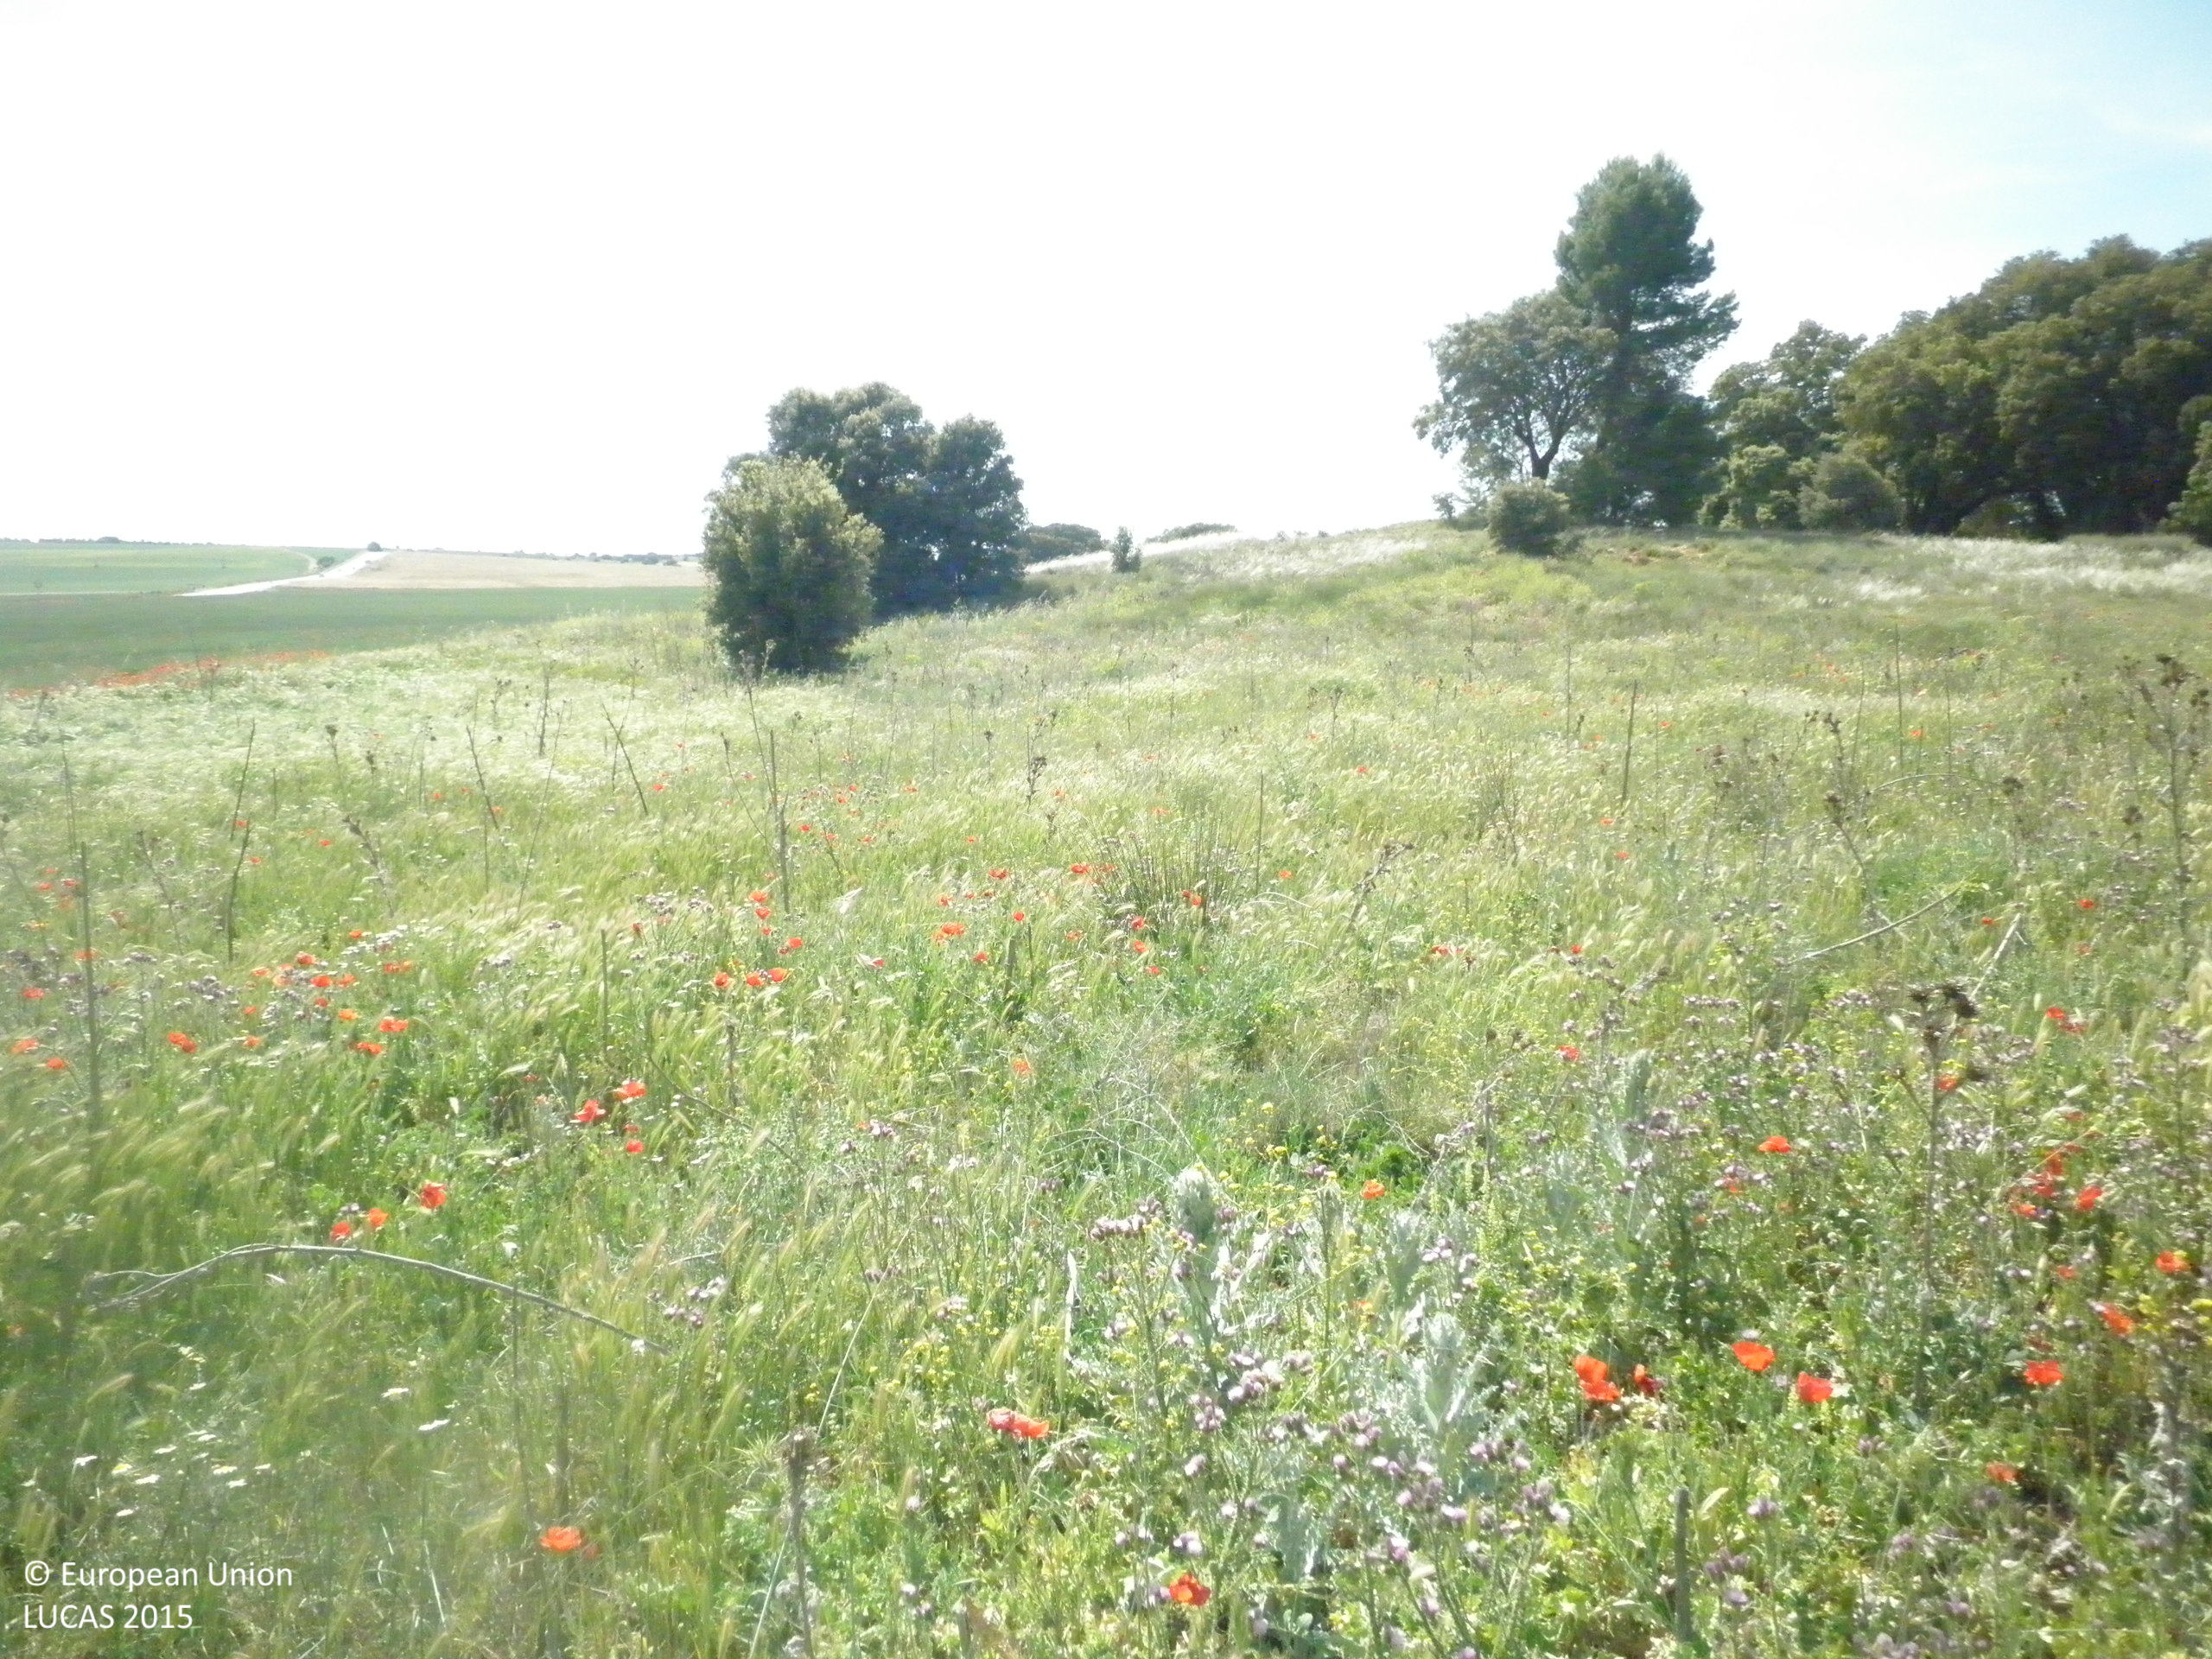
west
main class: Grassland
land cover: Grassland without tree/shrub cover
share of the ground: > 75 %
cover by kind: herbaceous plants 90 %, consolidated bare surface 10 %
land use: Abandoned areas
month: May
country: ES
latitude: 39.5346
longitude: -2.8020
